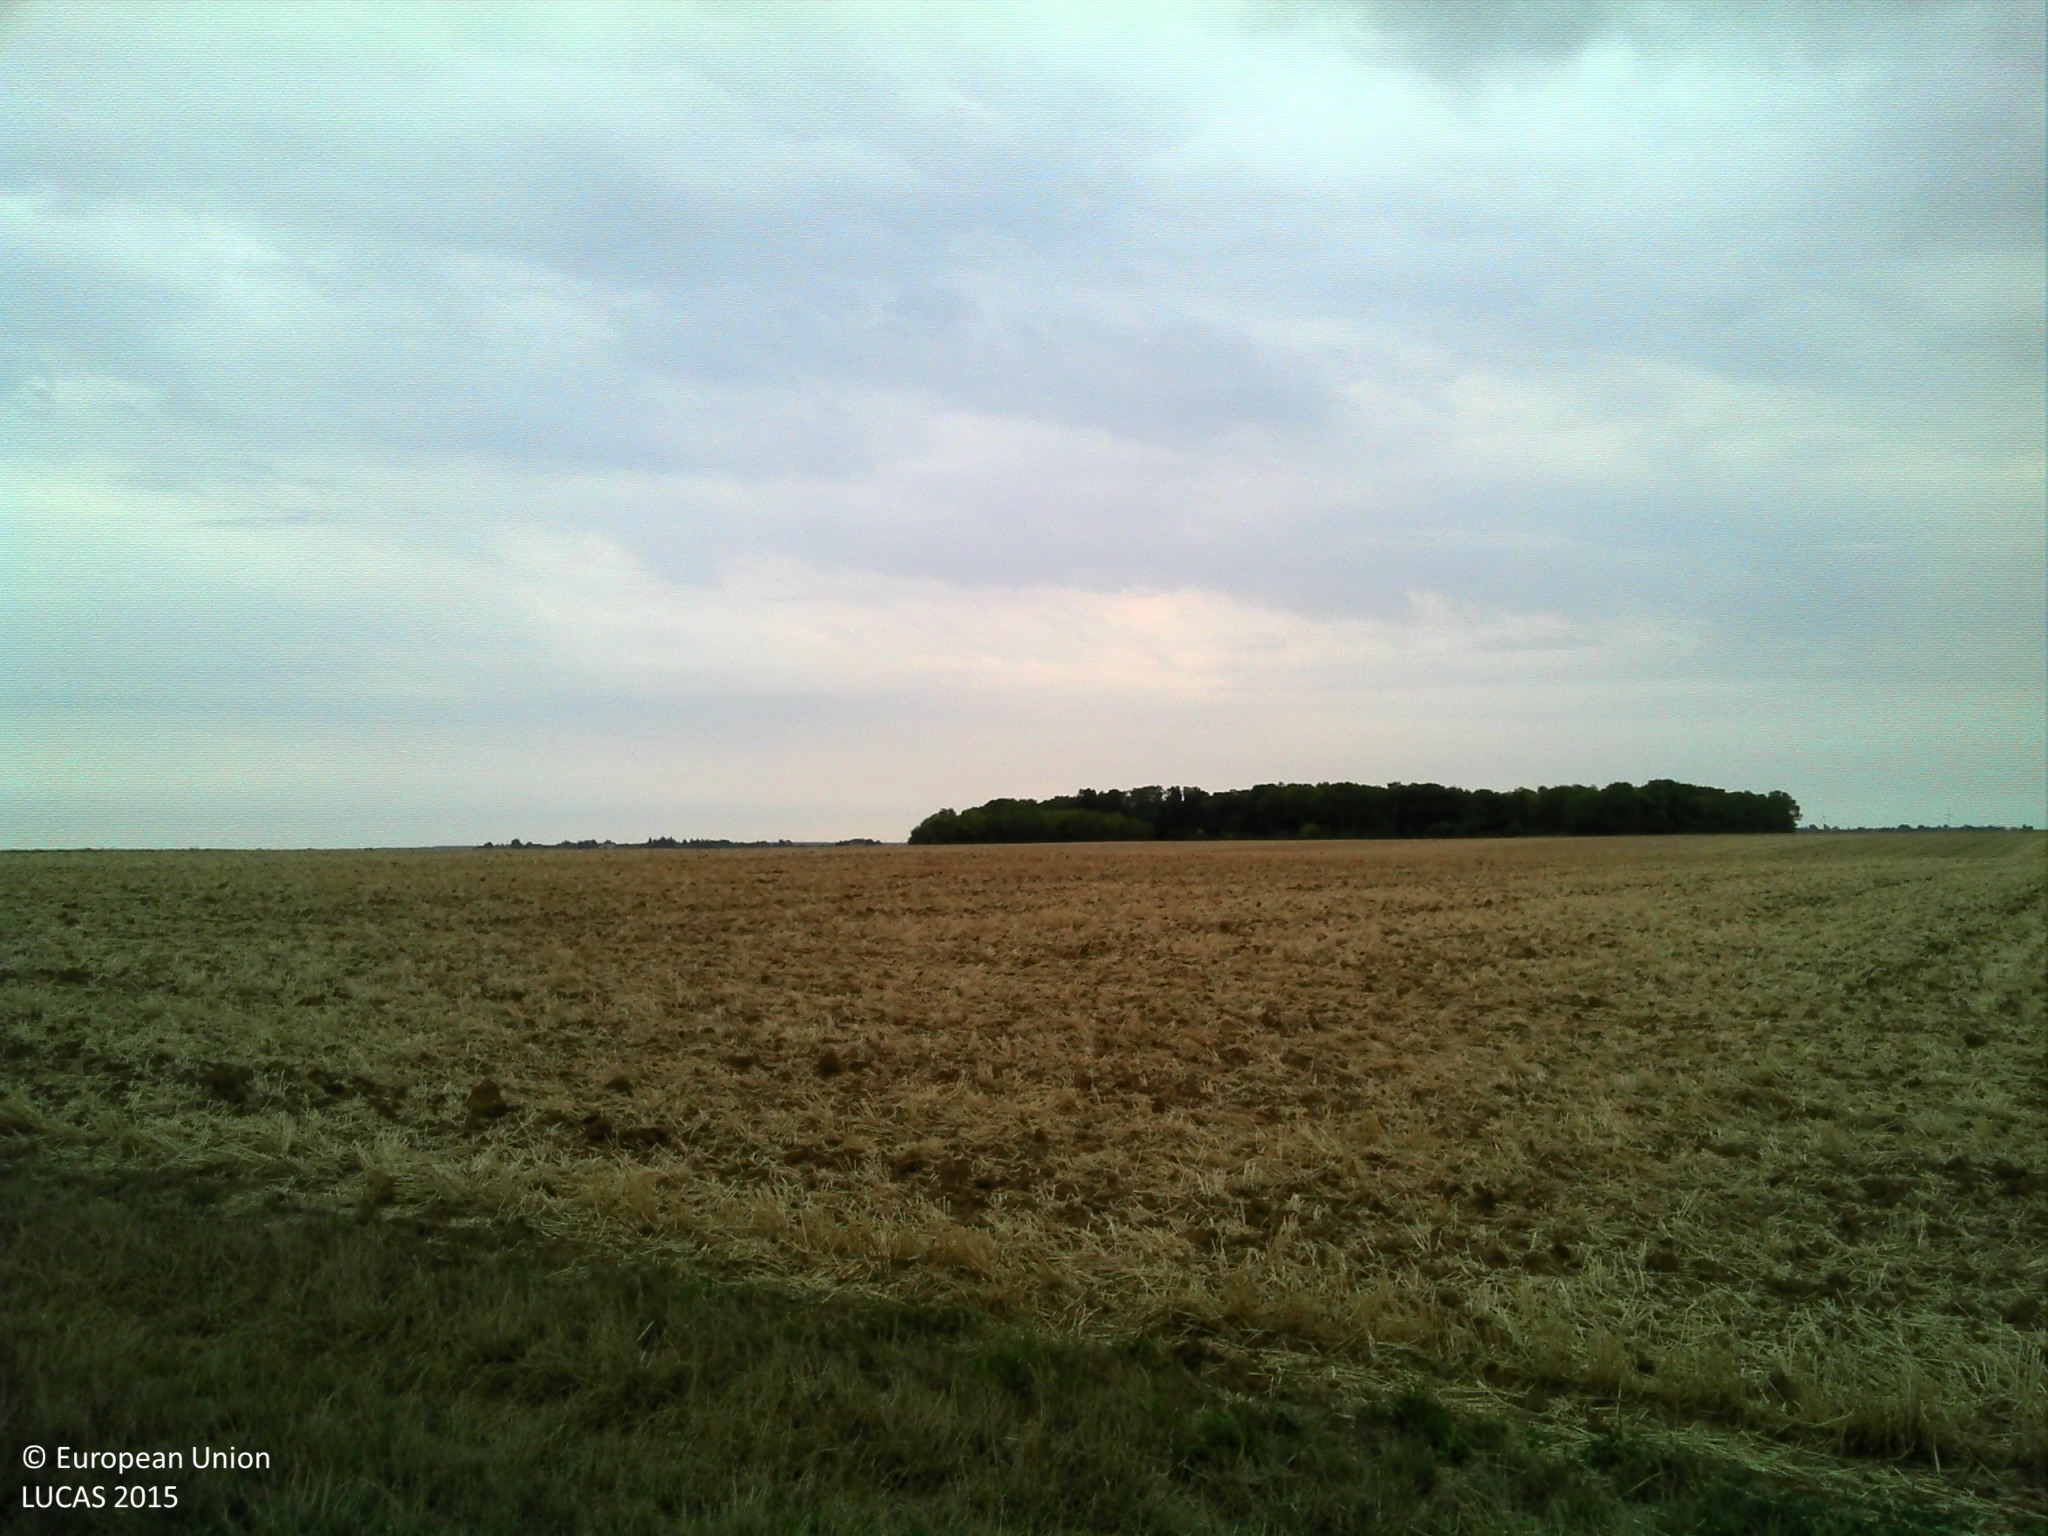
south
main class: Cropland
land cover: Sugar beet
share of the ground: > 75 %
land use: Agriculture (excluding fallow land and kitchen gardens)
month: August
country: FR
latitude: 48.2222
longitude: 2.5196
